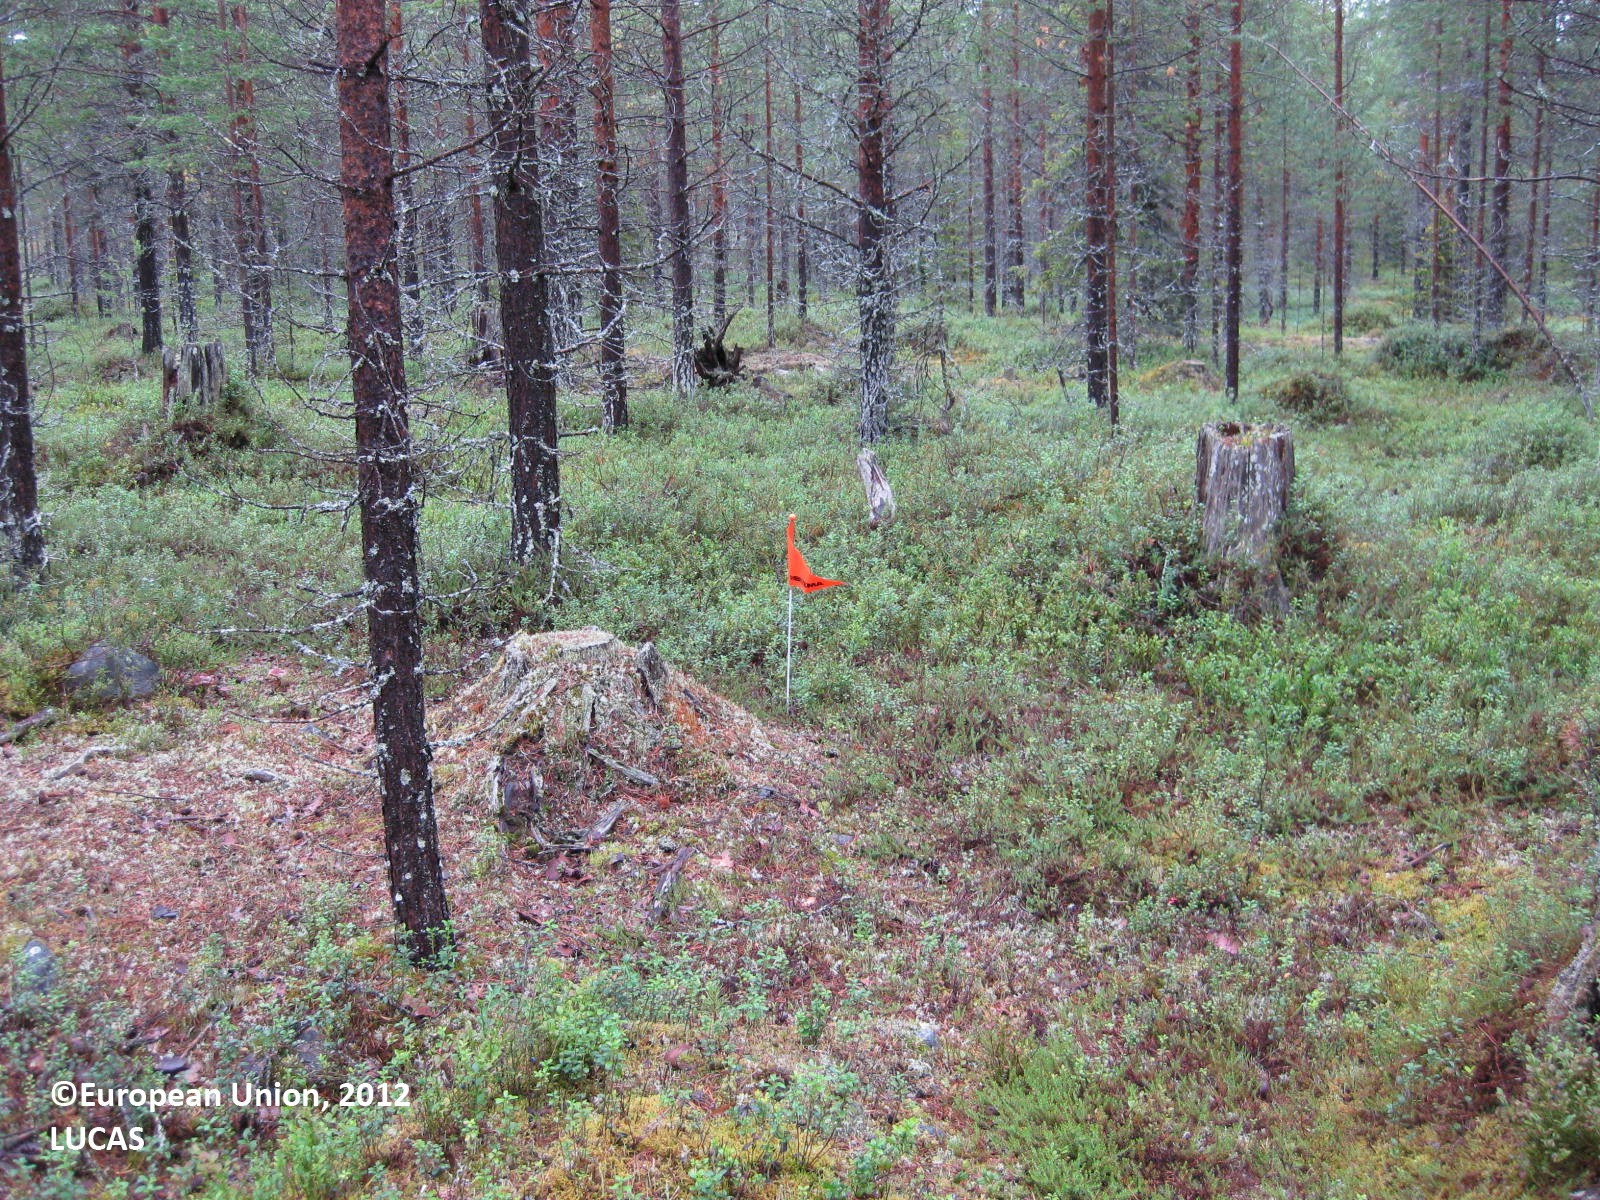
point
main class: Woodland
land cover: Pine dominated coniferous woodland
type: boreal forest
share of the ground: 50 - 75 %
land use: Forestry
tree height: > 5 m
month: August
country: FI
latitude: 65.9539
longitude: 28.2923
